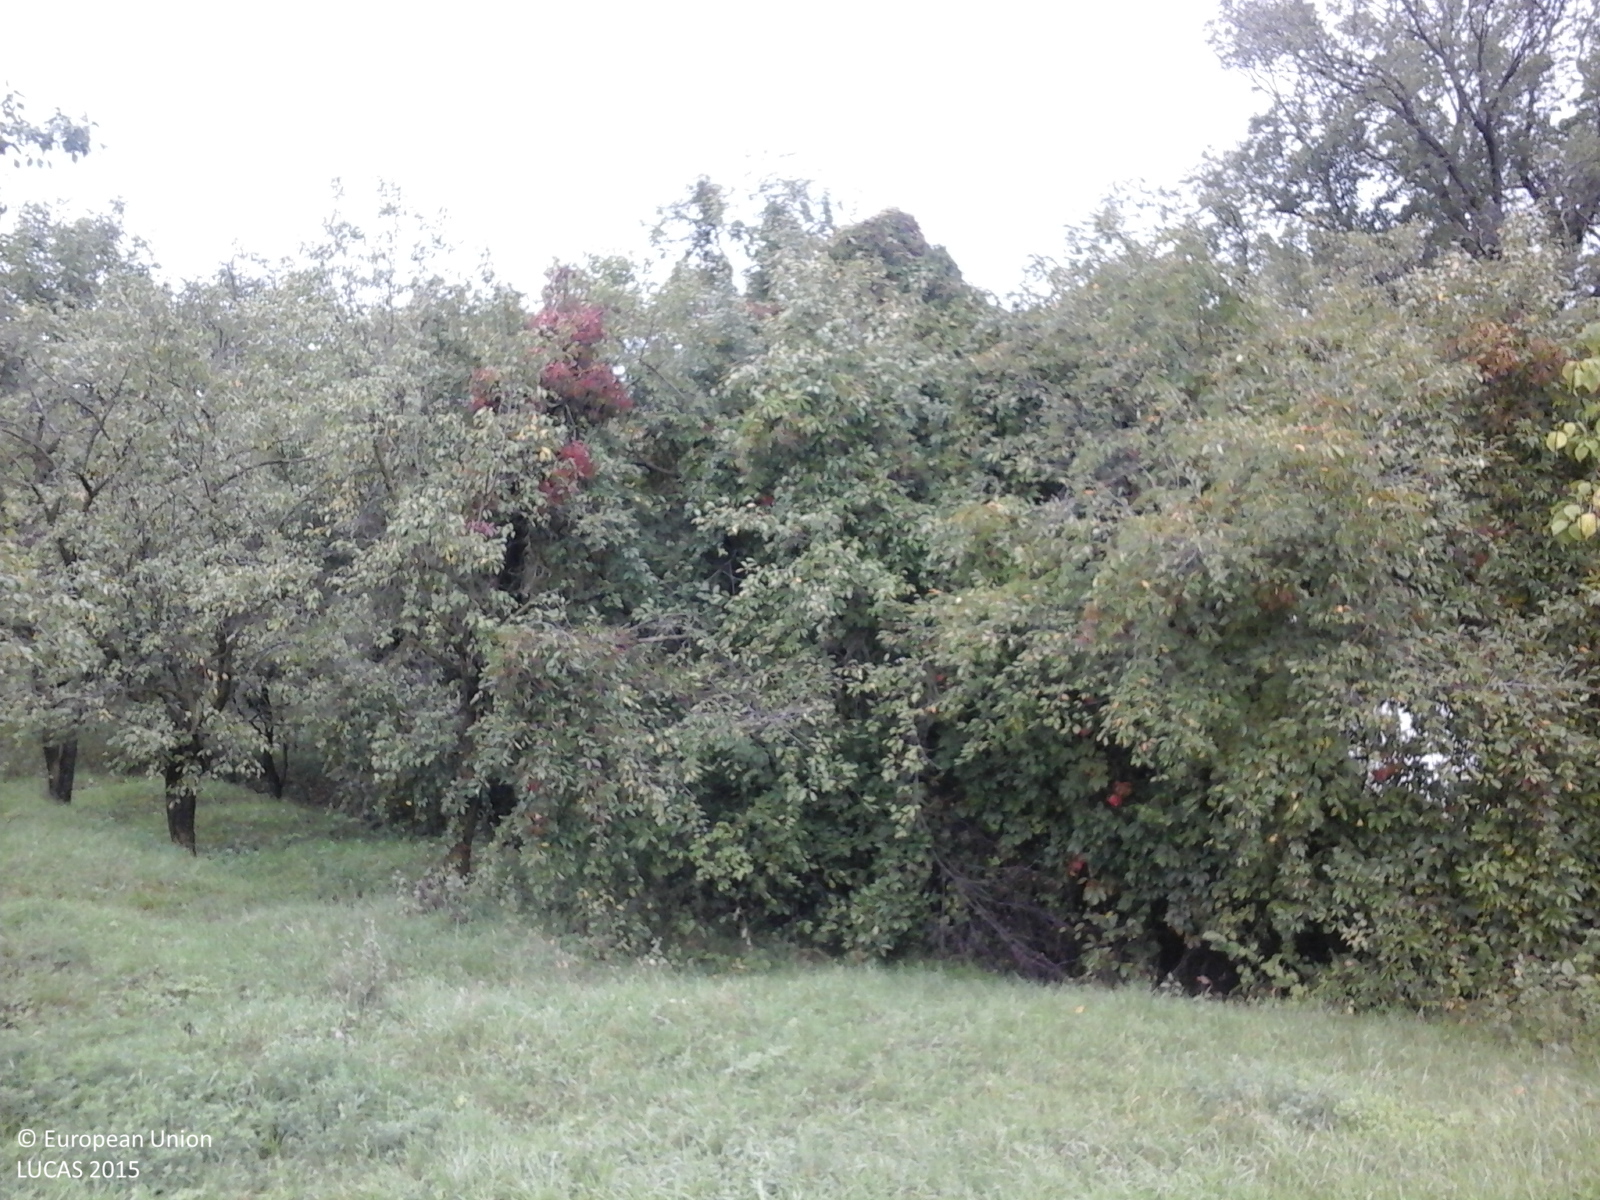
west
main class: Cropland
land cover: Other fruit trees and berries
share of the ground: > 75 %
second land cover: Grassland without tree/shrub cover
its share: > 75 %
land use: Agriculture (excluding fallow land and kitchen gardens)
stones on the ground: < 10 %
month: September
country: RO
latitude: 45.8895
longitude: 23.6622
